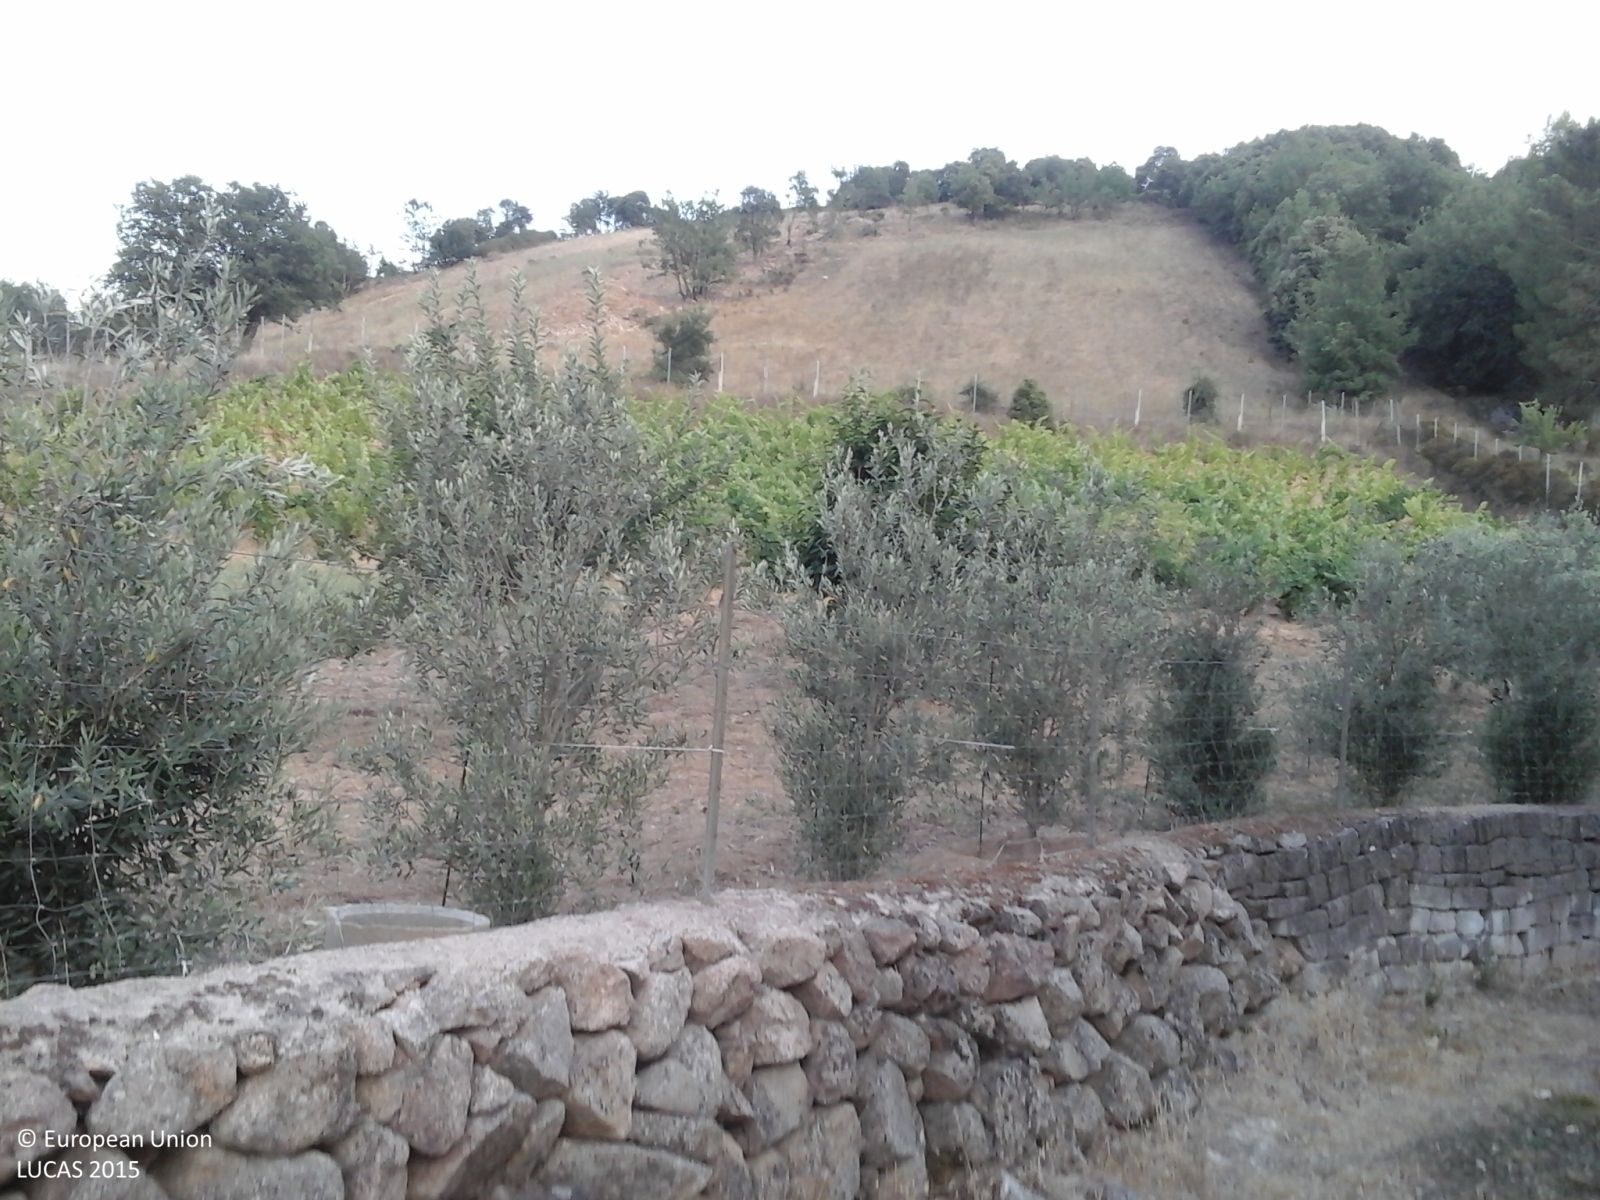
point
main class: Cropland
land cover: Vineyards
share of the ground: > 75 %
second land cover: Spontaneously vegetated surfaces
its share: 50 - 75 %
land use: Agriculture (excluding fallow land and kitchen gardens)
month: August
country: IT
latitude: 39.9724
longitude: 8.9869
